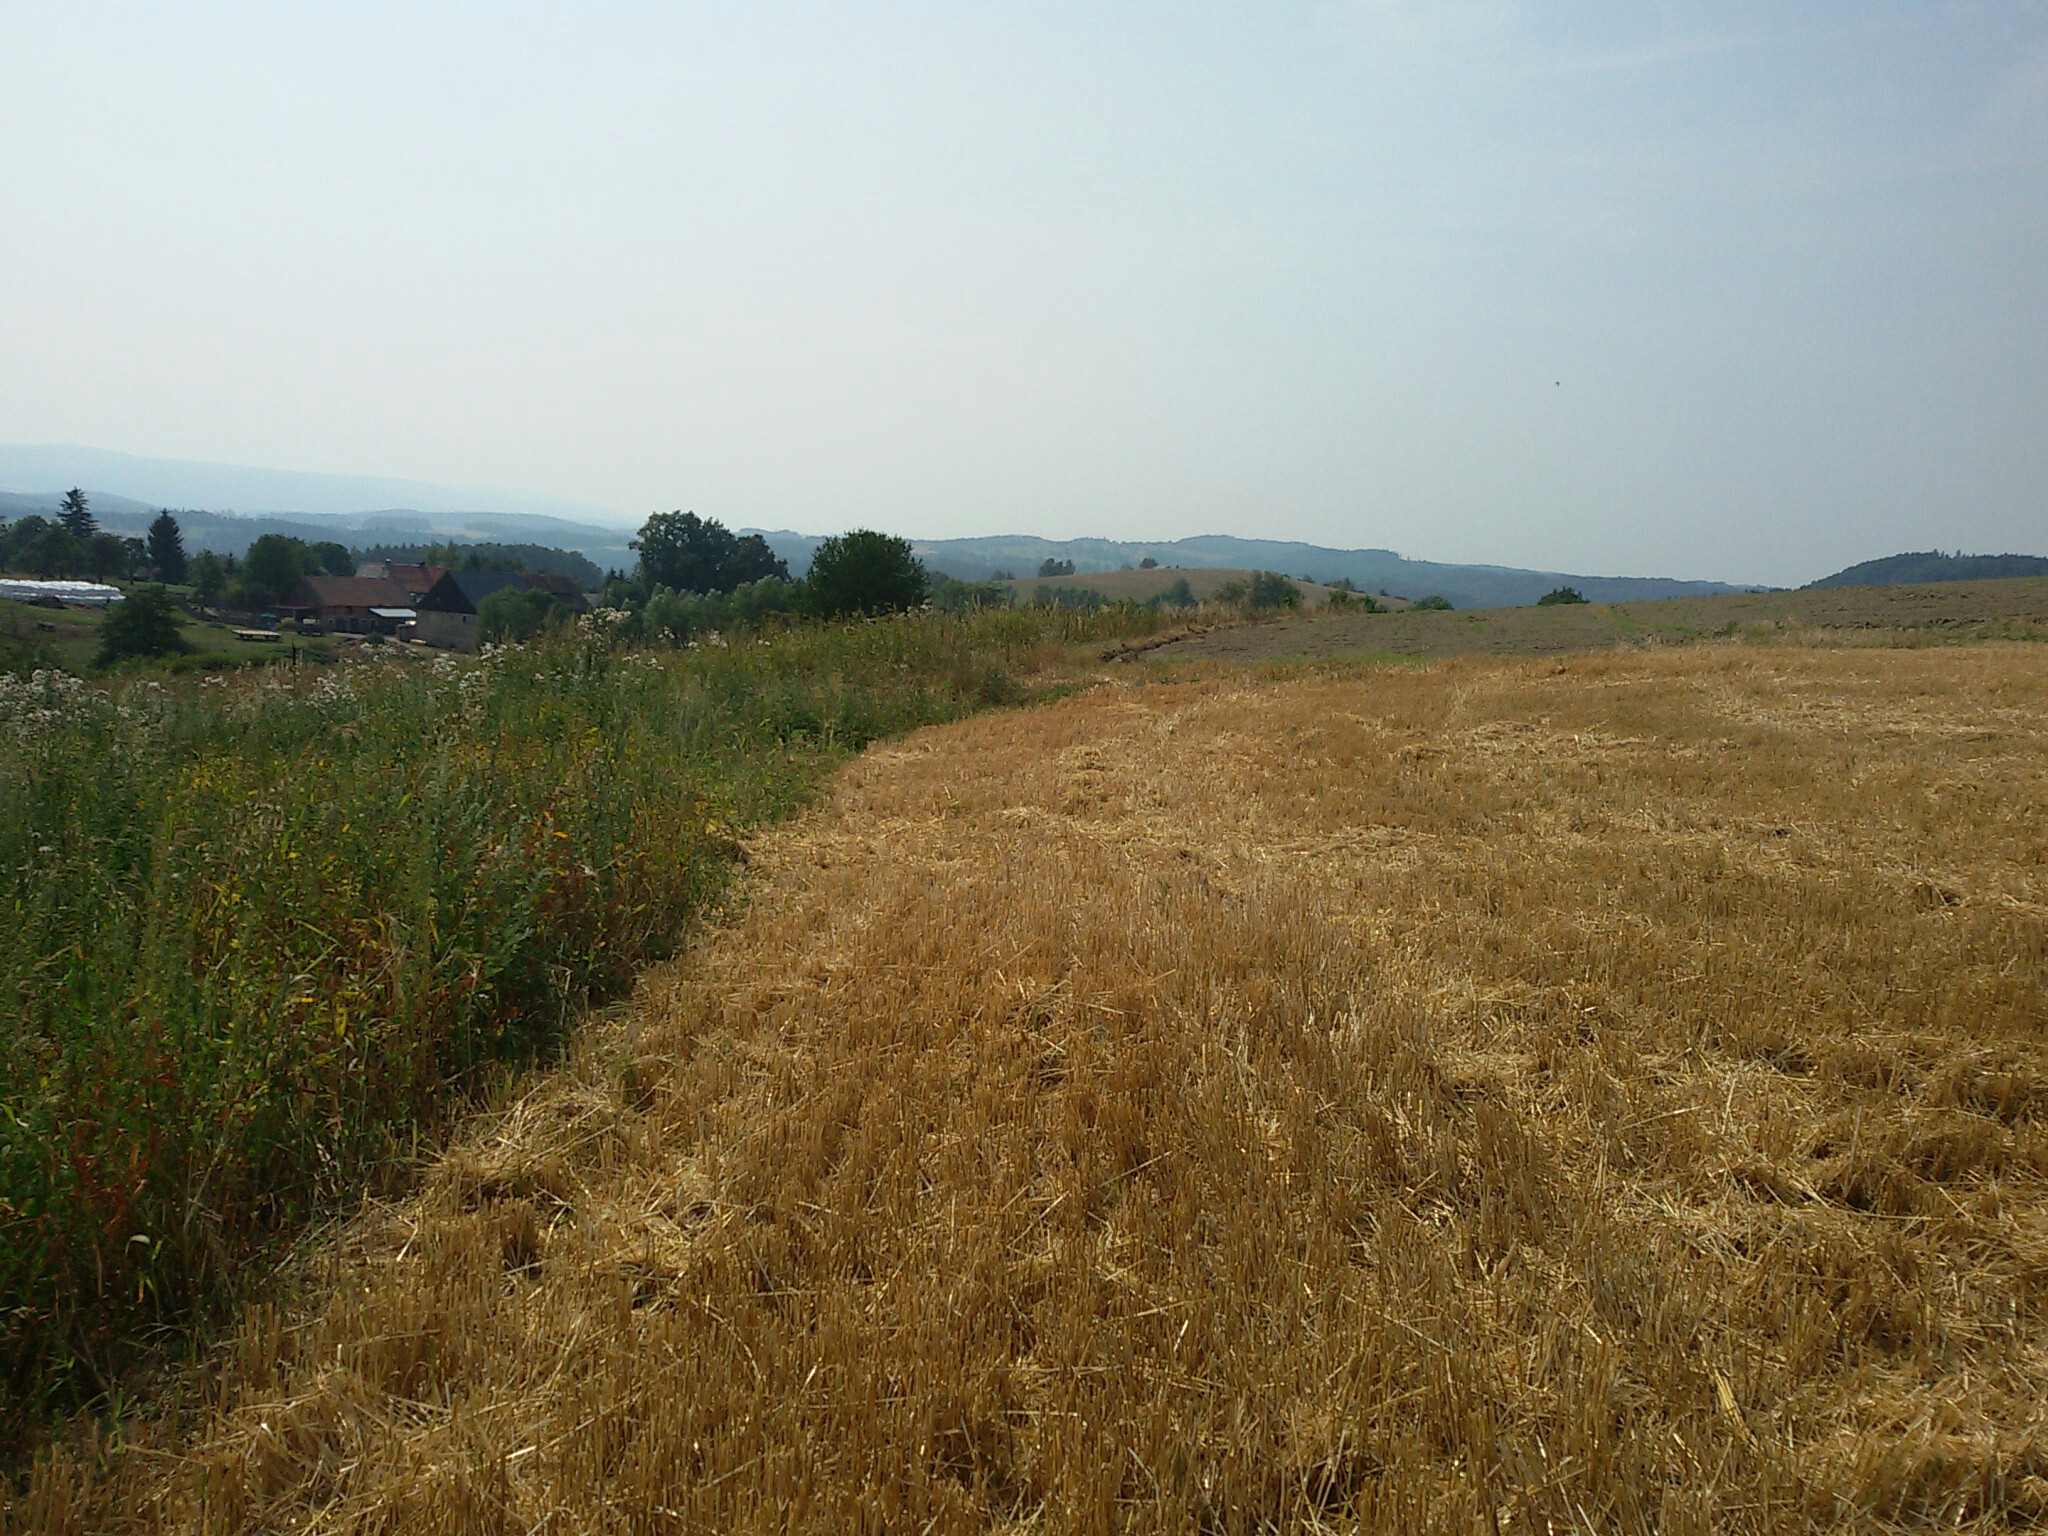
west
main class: Cropland
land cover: Barley
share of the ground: > 75 %
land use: Agriculture (excluding fallow land and kitchen gardens)
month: August
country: PL
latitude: 50.9617
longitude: 15.6858
